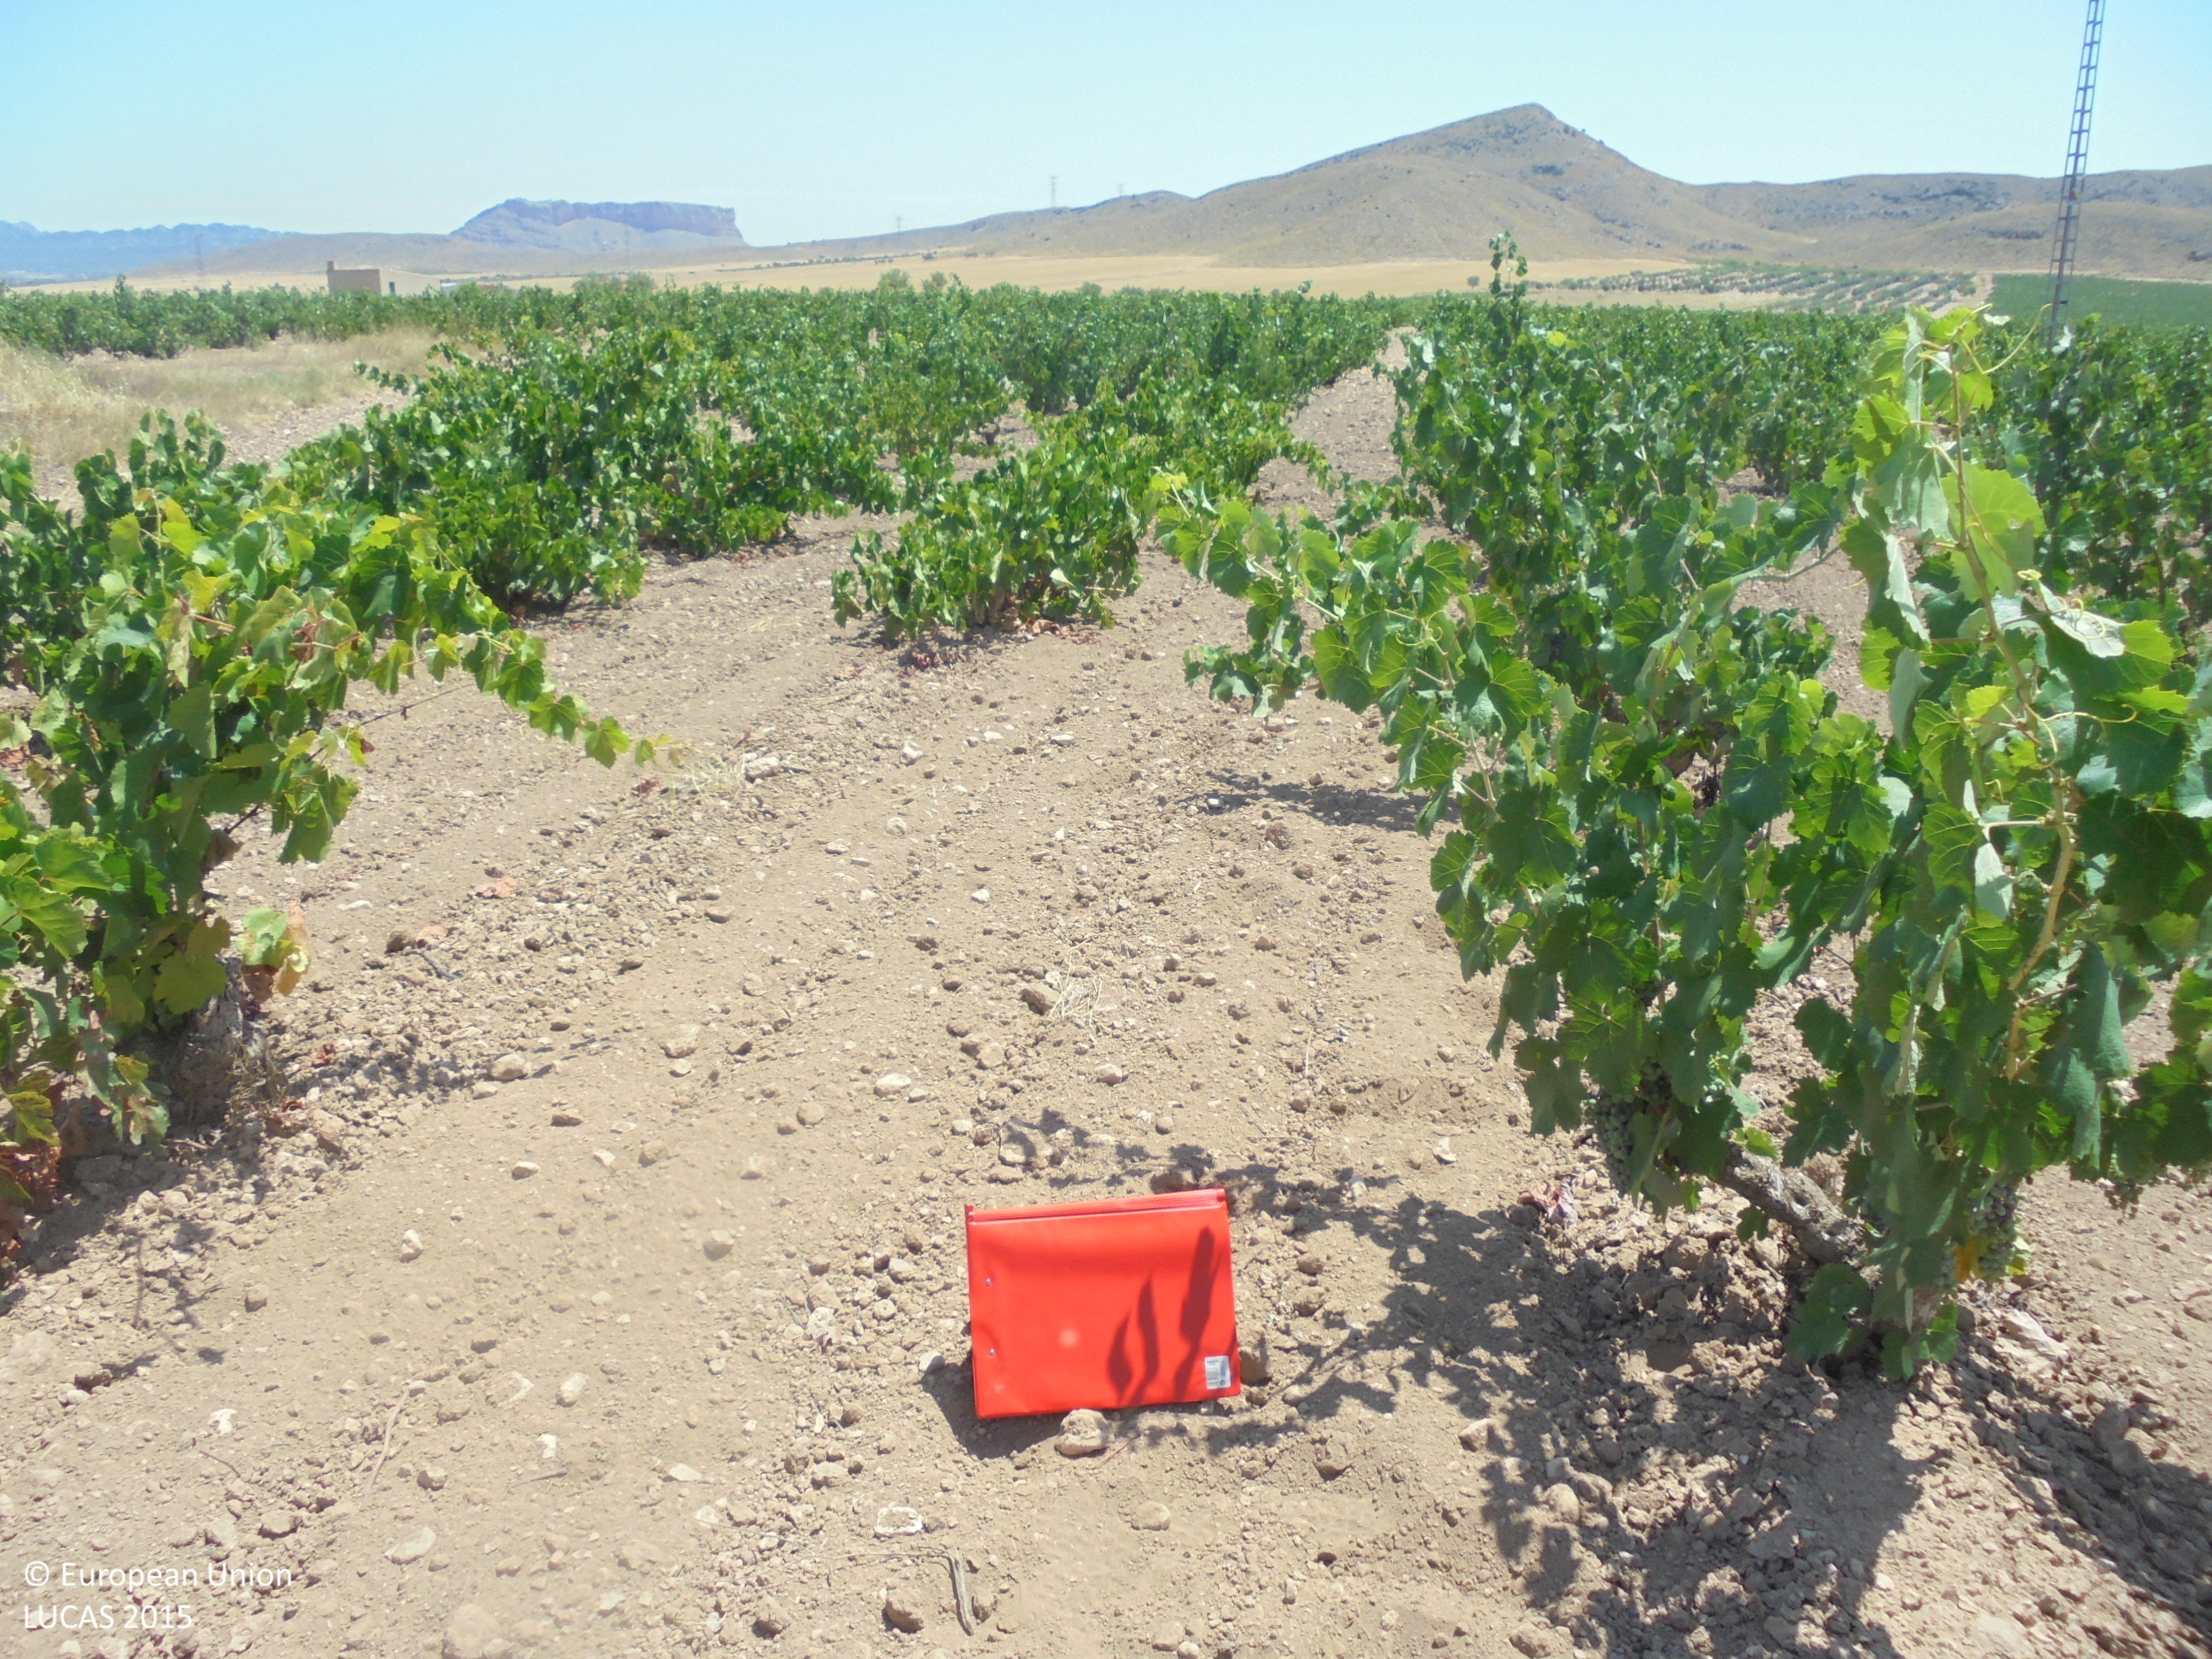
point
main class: Cropland
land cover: Vineyards
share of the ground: 25 - 50 %
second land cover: Other bare soil
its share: > 75 %
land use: Agriculture (excluding fallow land and kitchen gardens)
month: July
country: ES
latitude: 38.5429
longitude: -1.3848
